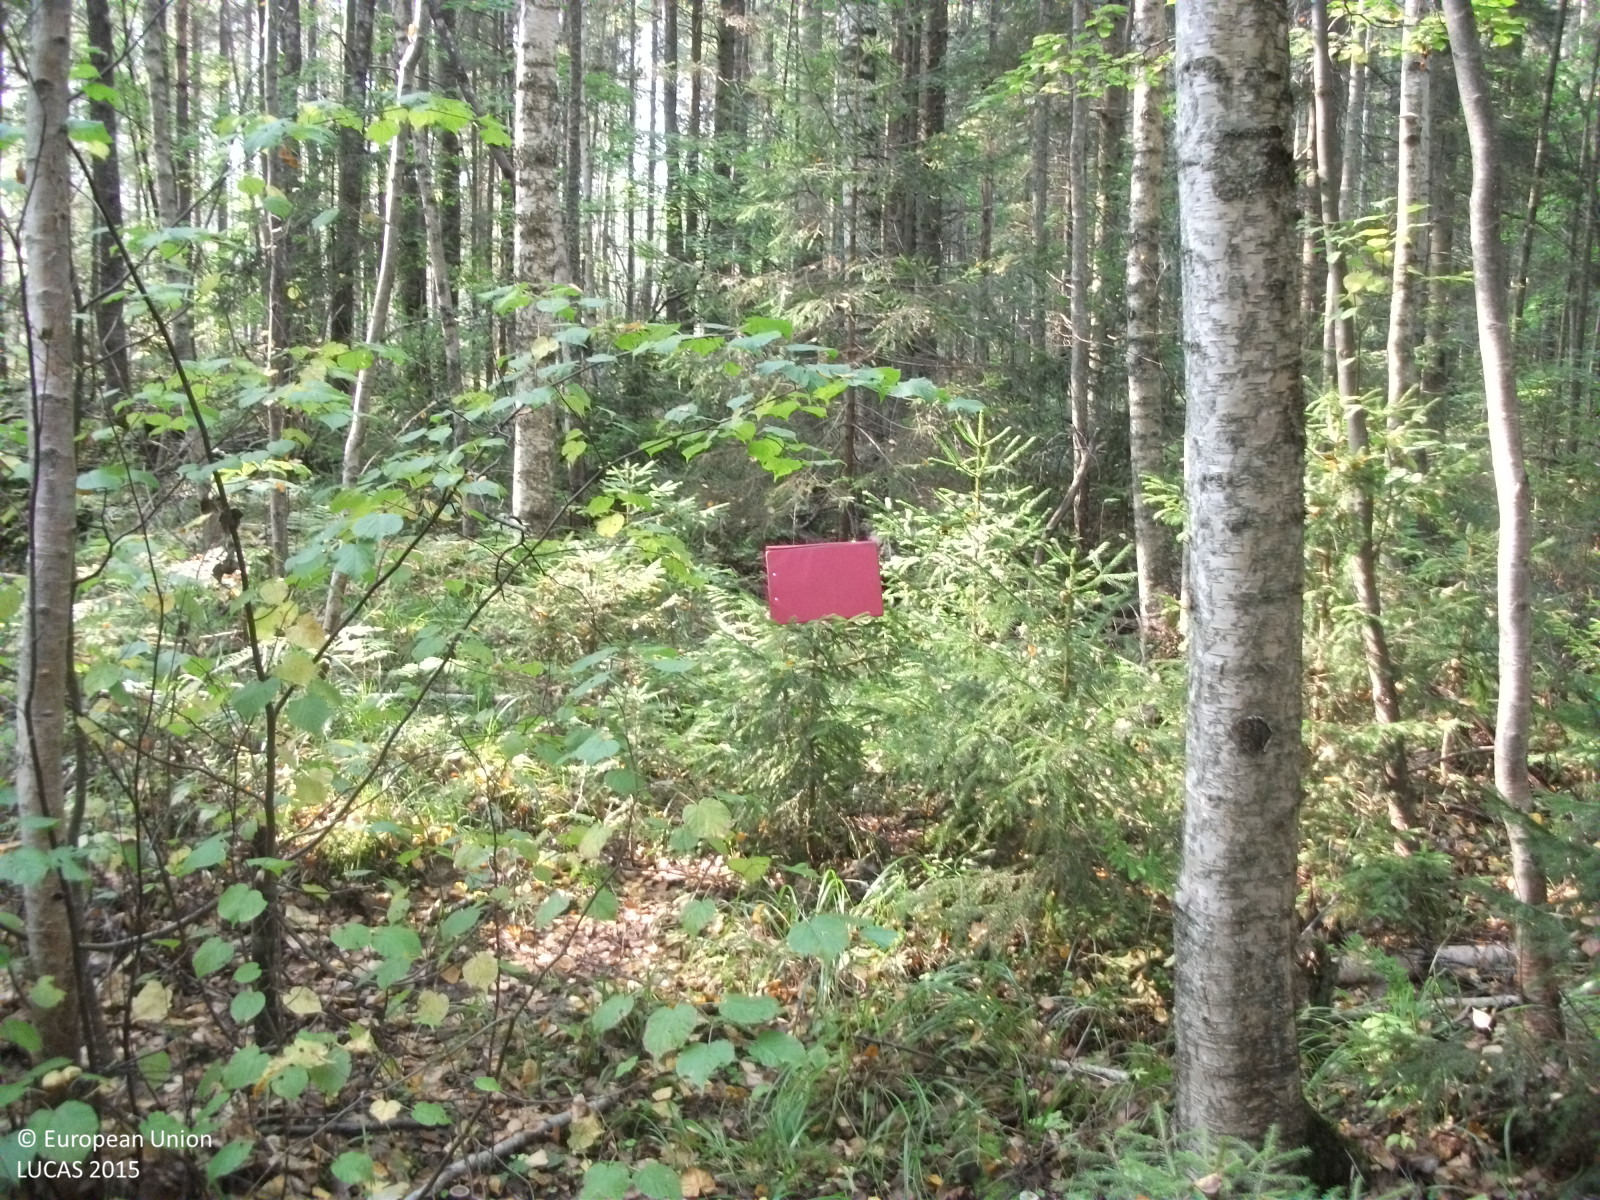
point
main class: Woodland
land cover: Spruce dominated mixed woodland
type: hemiboreal forest and nemoral coniferous forest and mixed broadleaved-coniferous forest
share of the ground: > 75 %
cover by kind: coniferous forest trees 50 %, broadleaved forest trees 30 %, herbaceous plants 10 %, shrubs 5 %, unconsolidated bare surface 5 %
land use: Forestry
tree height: > 5 m
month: September
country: LV
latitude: 57.8105
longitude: 24.5132
